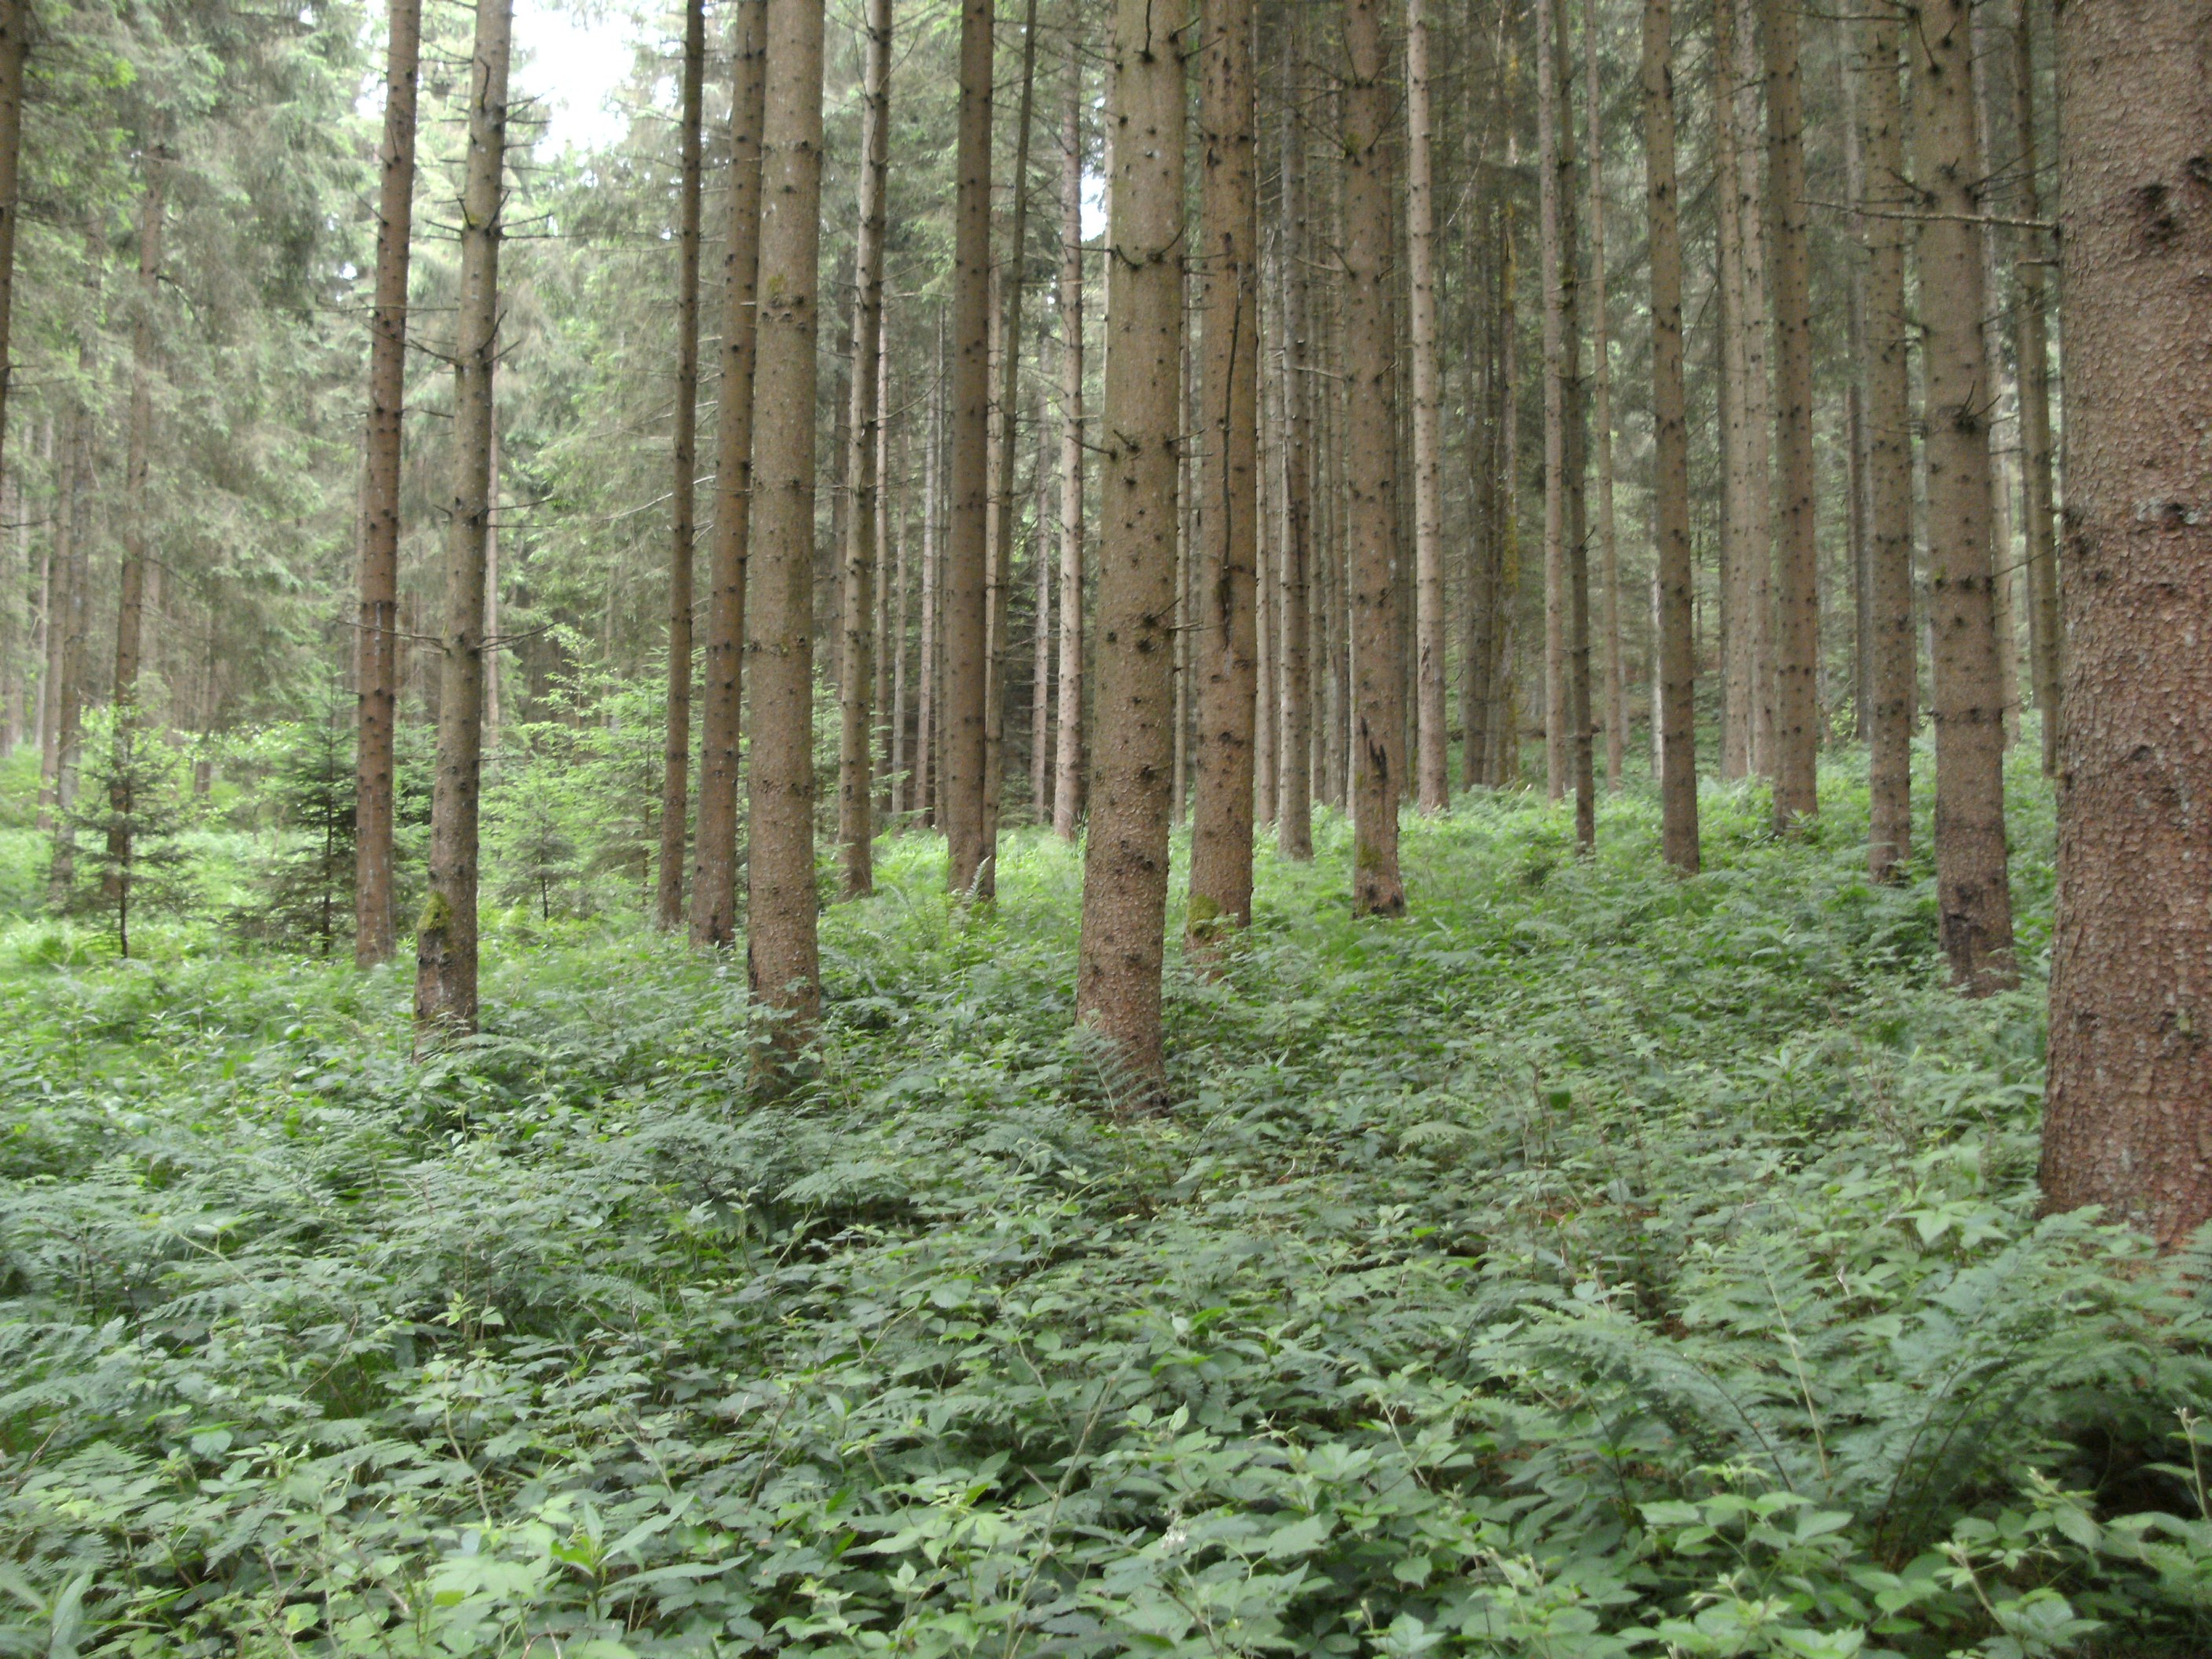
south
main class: Woodland
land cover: Spruce dominated coniferous woodland
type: hemiboreal forest and nemoral coniferous forest and mixed broadleaved-coniferous forest
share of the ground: 50 - 75 %
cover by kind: coniferous forest trees 75 %, shrubs 10 %, herbaceous plants 10 %, broadleaved forest trees 5 %
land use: Forestry
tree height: > 5 m
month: June
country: AT
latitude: 48.5066
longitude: 14.1285
